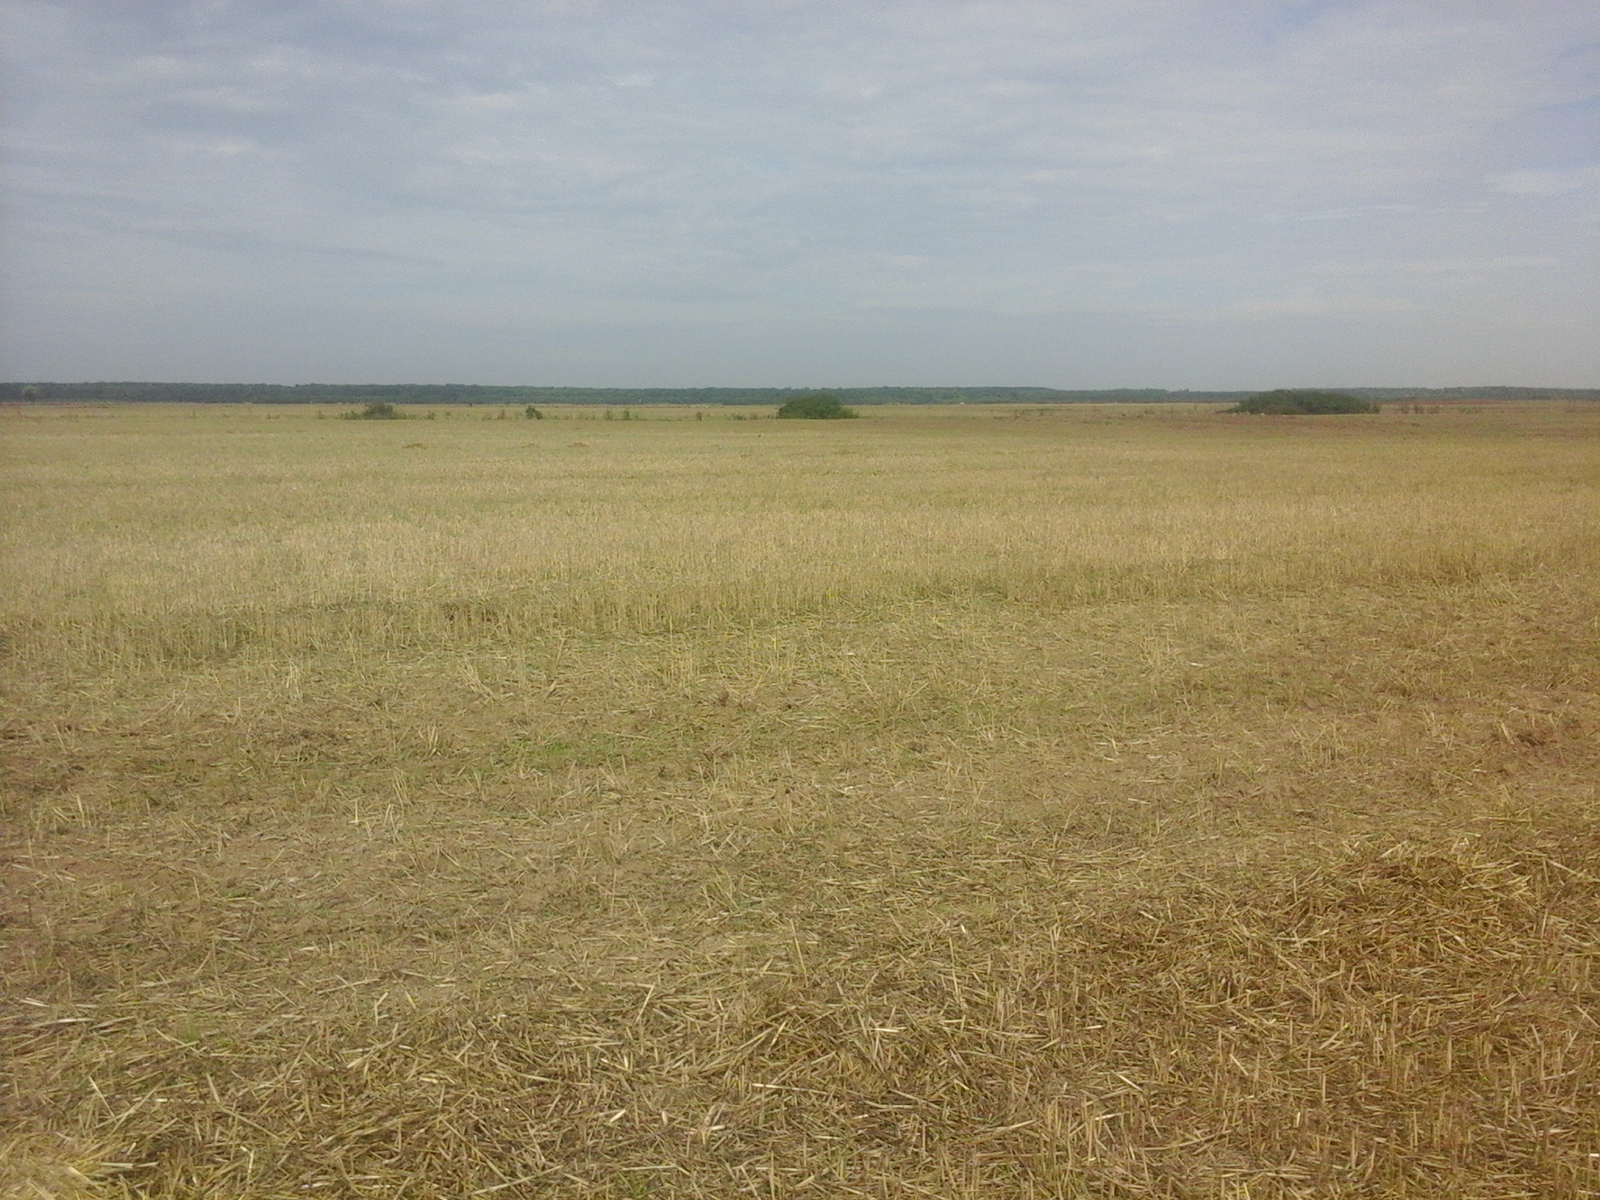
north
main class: Cropland
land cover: Common wheat
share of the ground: > 75 %
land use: Agriculture (excluding fallow land and kitchen gardens)
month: August
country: RO
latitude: 46.5468
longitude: 21.5015
